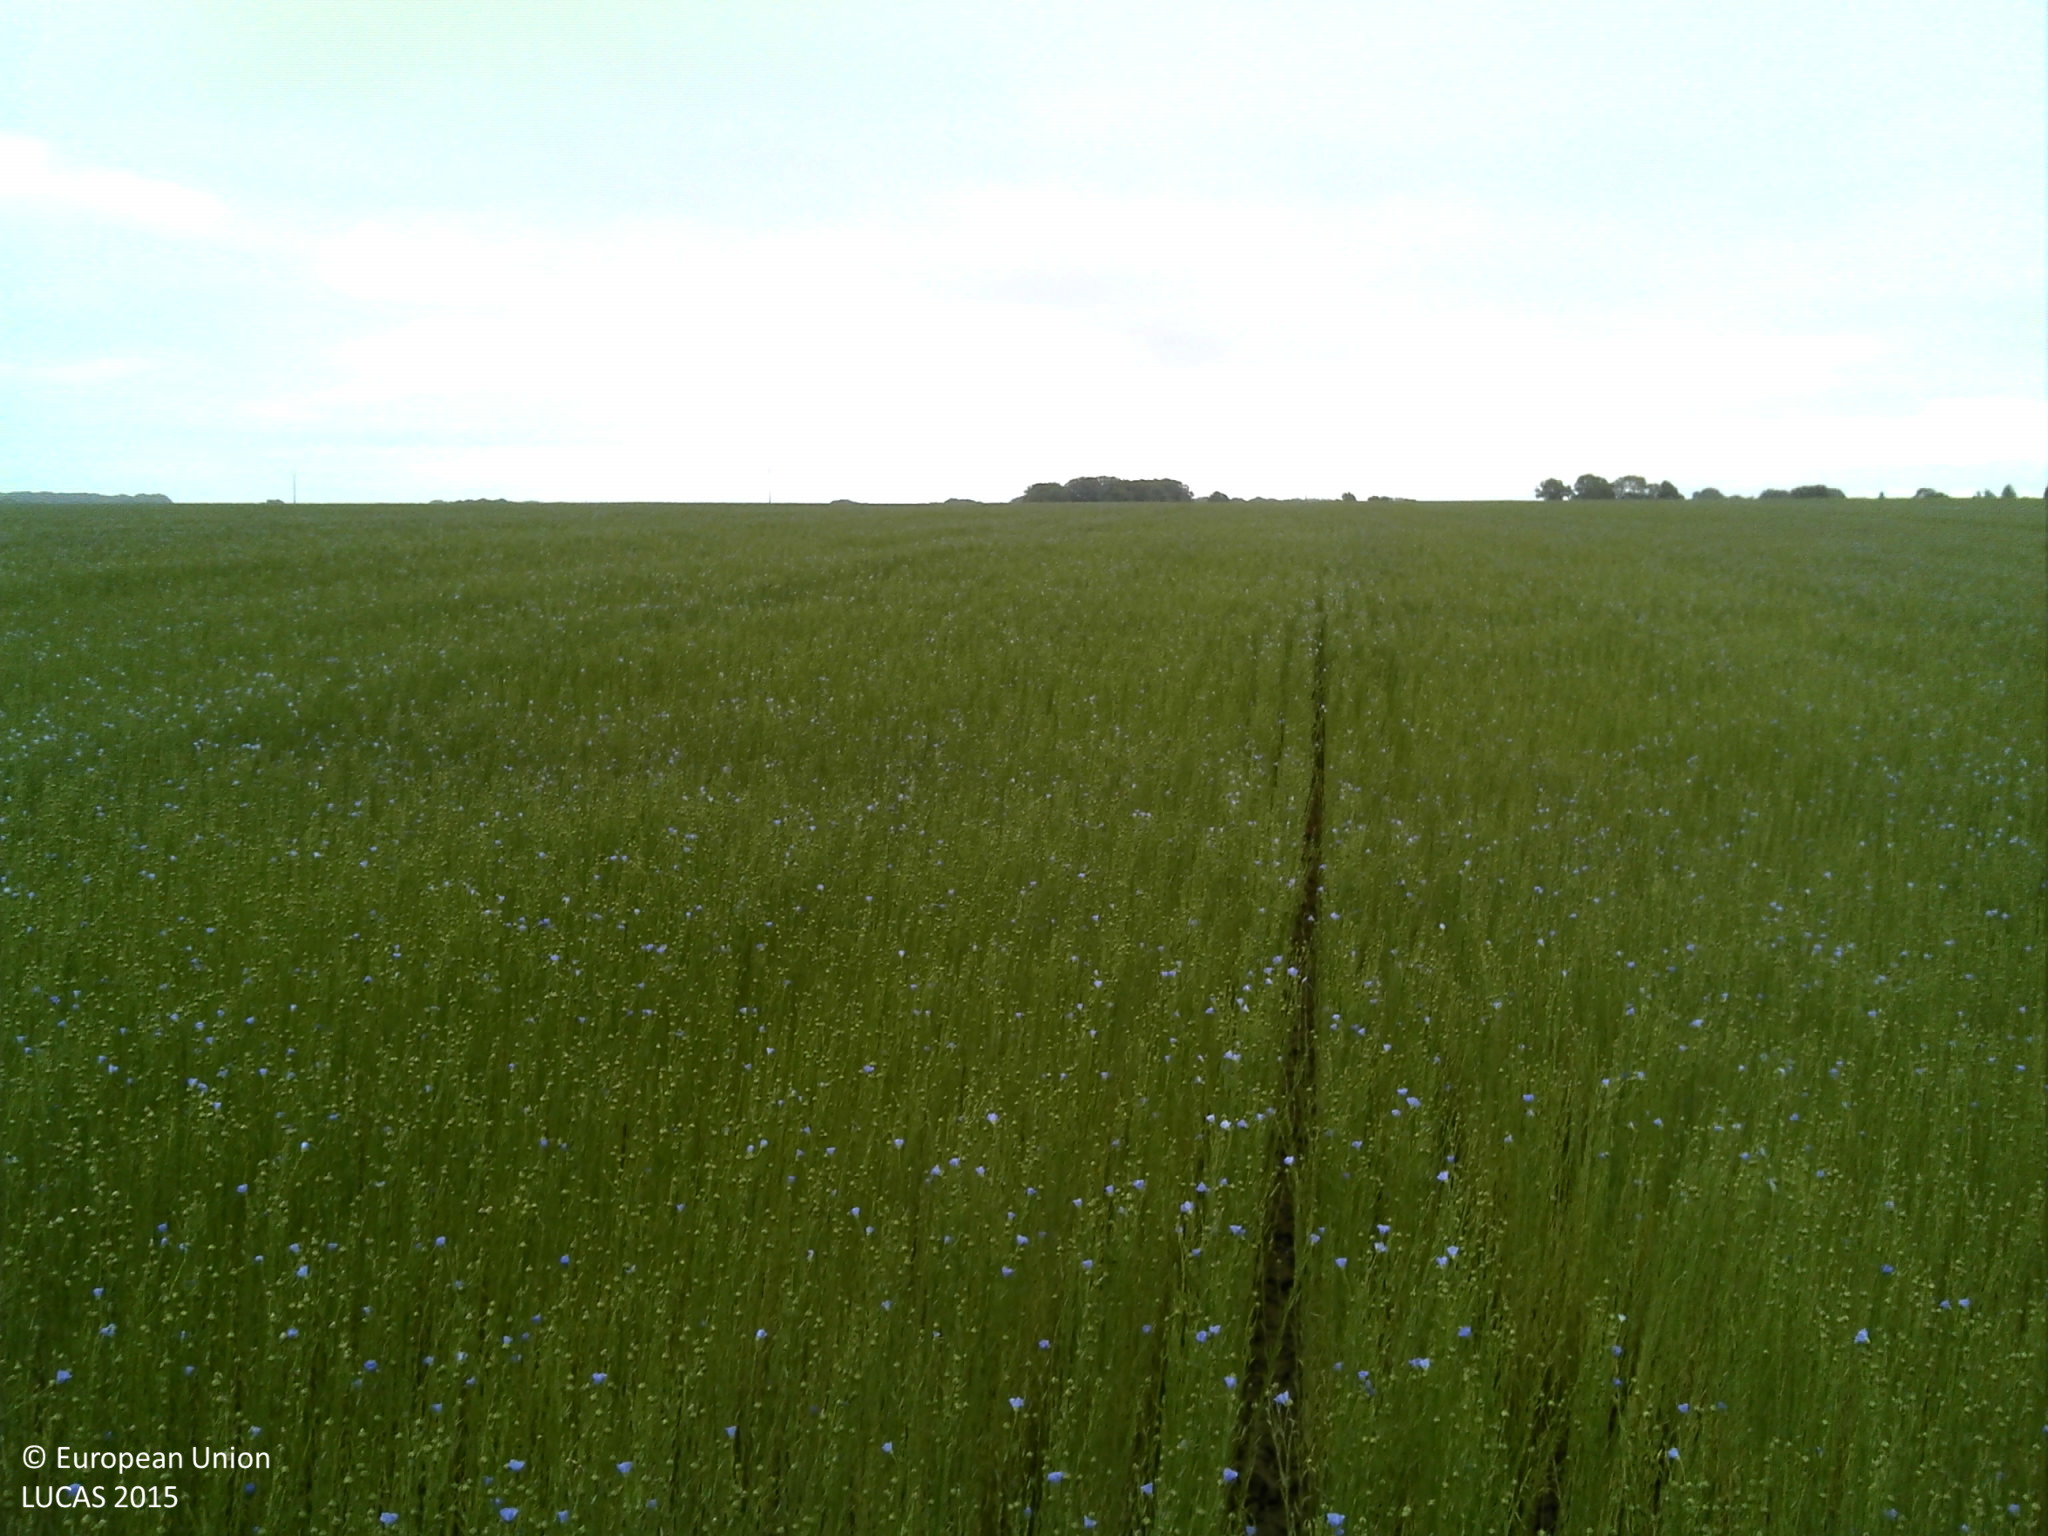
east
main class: Cropland
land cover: Other fibre and oleaginous crops
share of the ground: > 75 %
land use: Agriculture (excluding fallow land and kitchen gardens)
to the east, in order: Other fibre and oleaginous crops; Common wheat
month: June
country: FR
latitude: 49.7035
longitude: 0.5868
